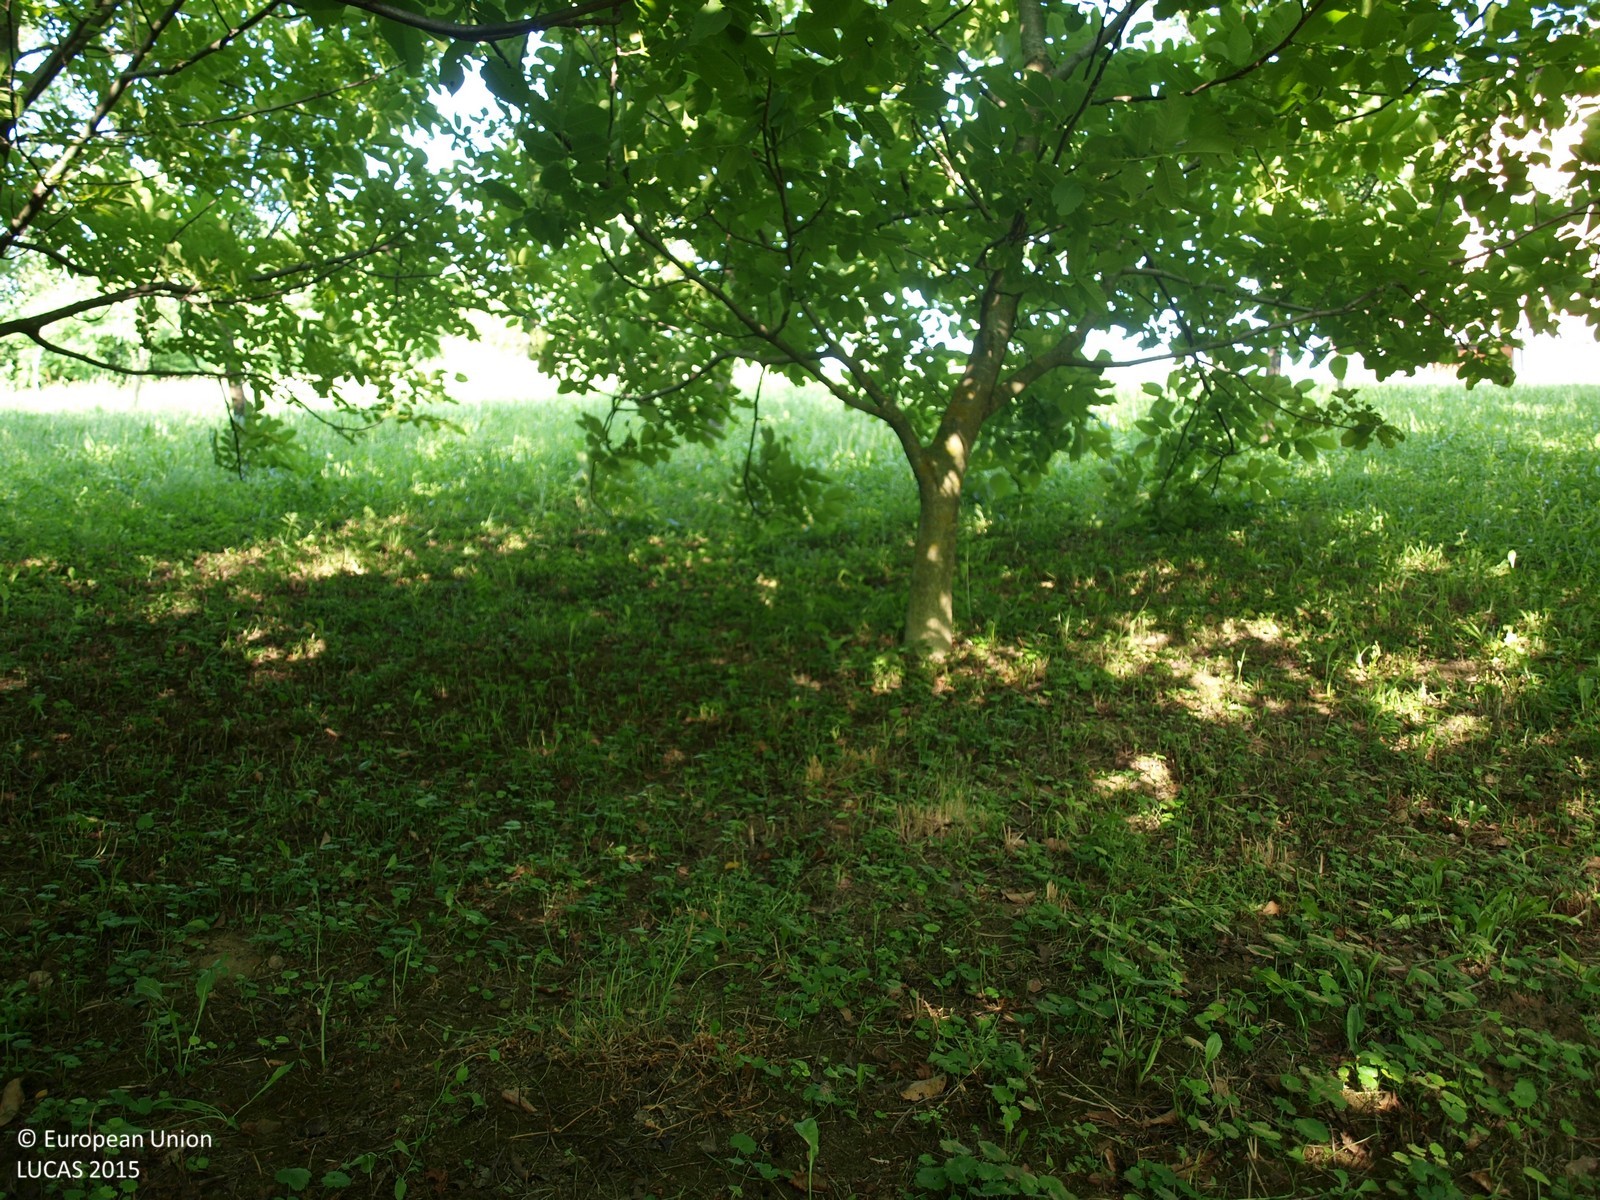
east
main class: Cropland
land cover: Nuts trees
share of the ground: 50 - 75 %
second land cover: Grassland without tree/shrub cover
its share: > 75 %
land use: Agriculture (excluding fallow land and kitchen gardens)
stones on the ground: < 10 %
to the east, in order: Nuts trees; Grassland without tree/shrub cover; Other fresh vegetables; Grassland without tree/shrub cover; Abandoned hedges; Paved roads, cycling and walking lanes; Managed hedges; Artificial constructions in urban areas; Shrubland without tree cover; Spontaneously vegetated surfaces; Broadleaved woodland
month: June
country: HR
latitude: 46.1620
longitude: 16.3584
